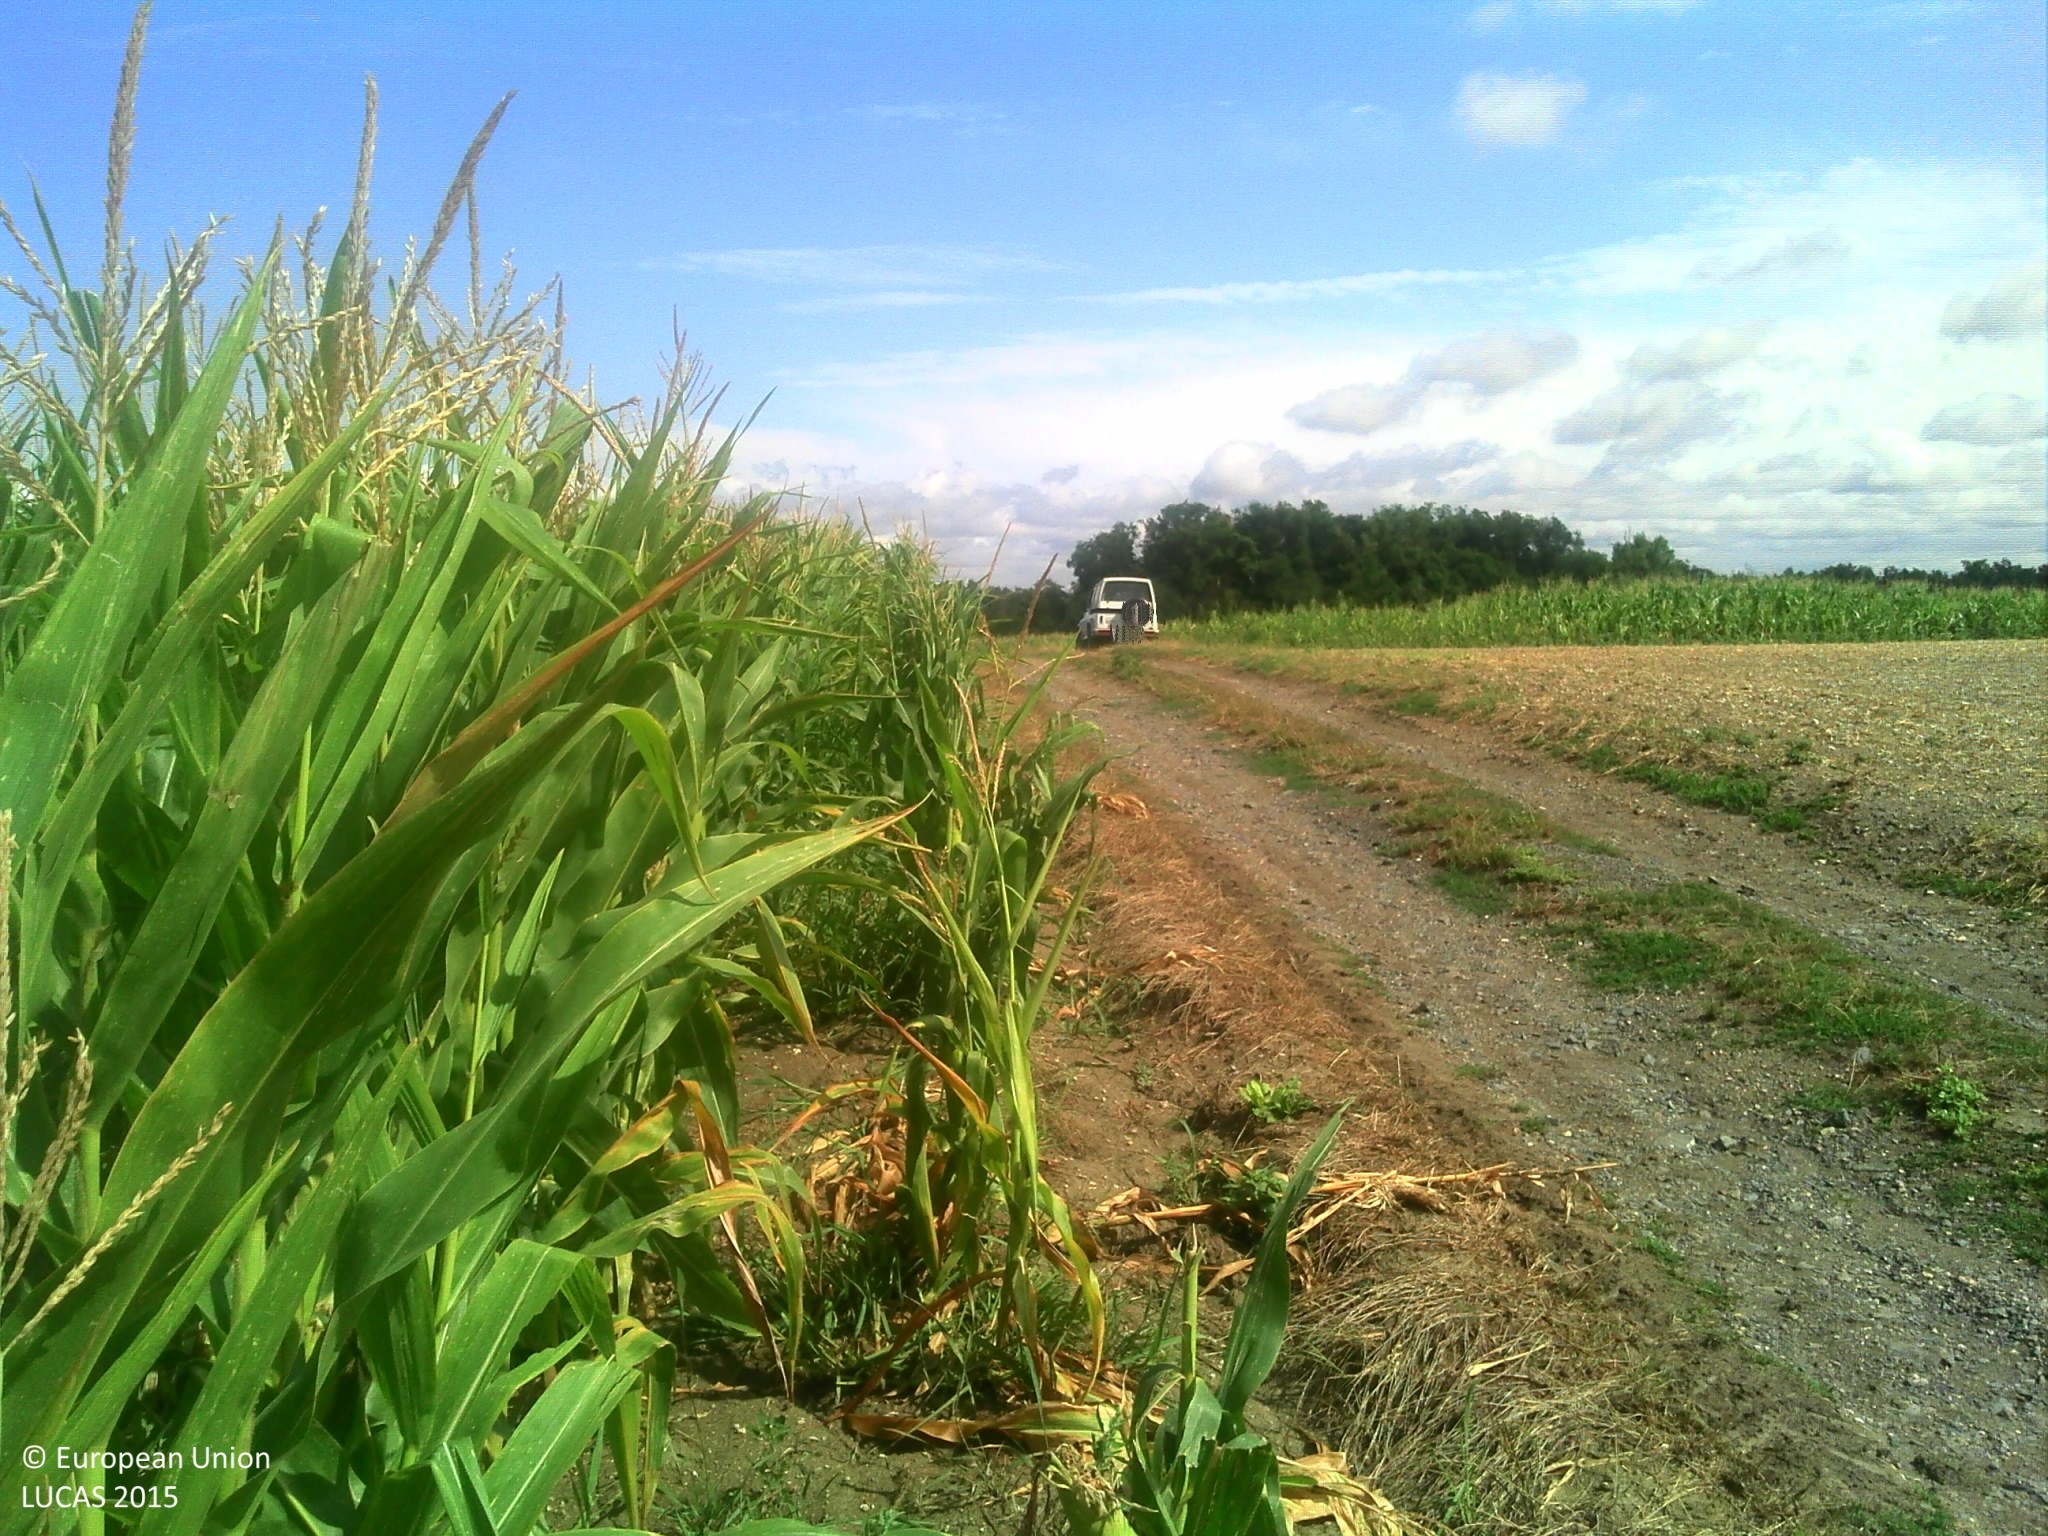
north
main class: Cropland
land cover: Maize
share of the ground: > 75 %
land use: Agriculture (excluding fallow land and kitchen gardens)
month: August
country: FR
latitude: 45.5934
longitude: 4.1191
